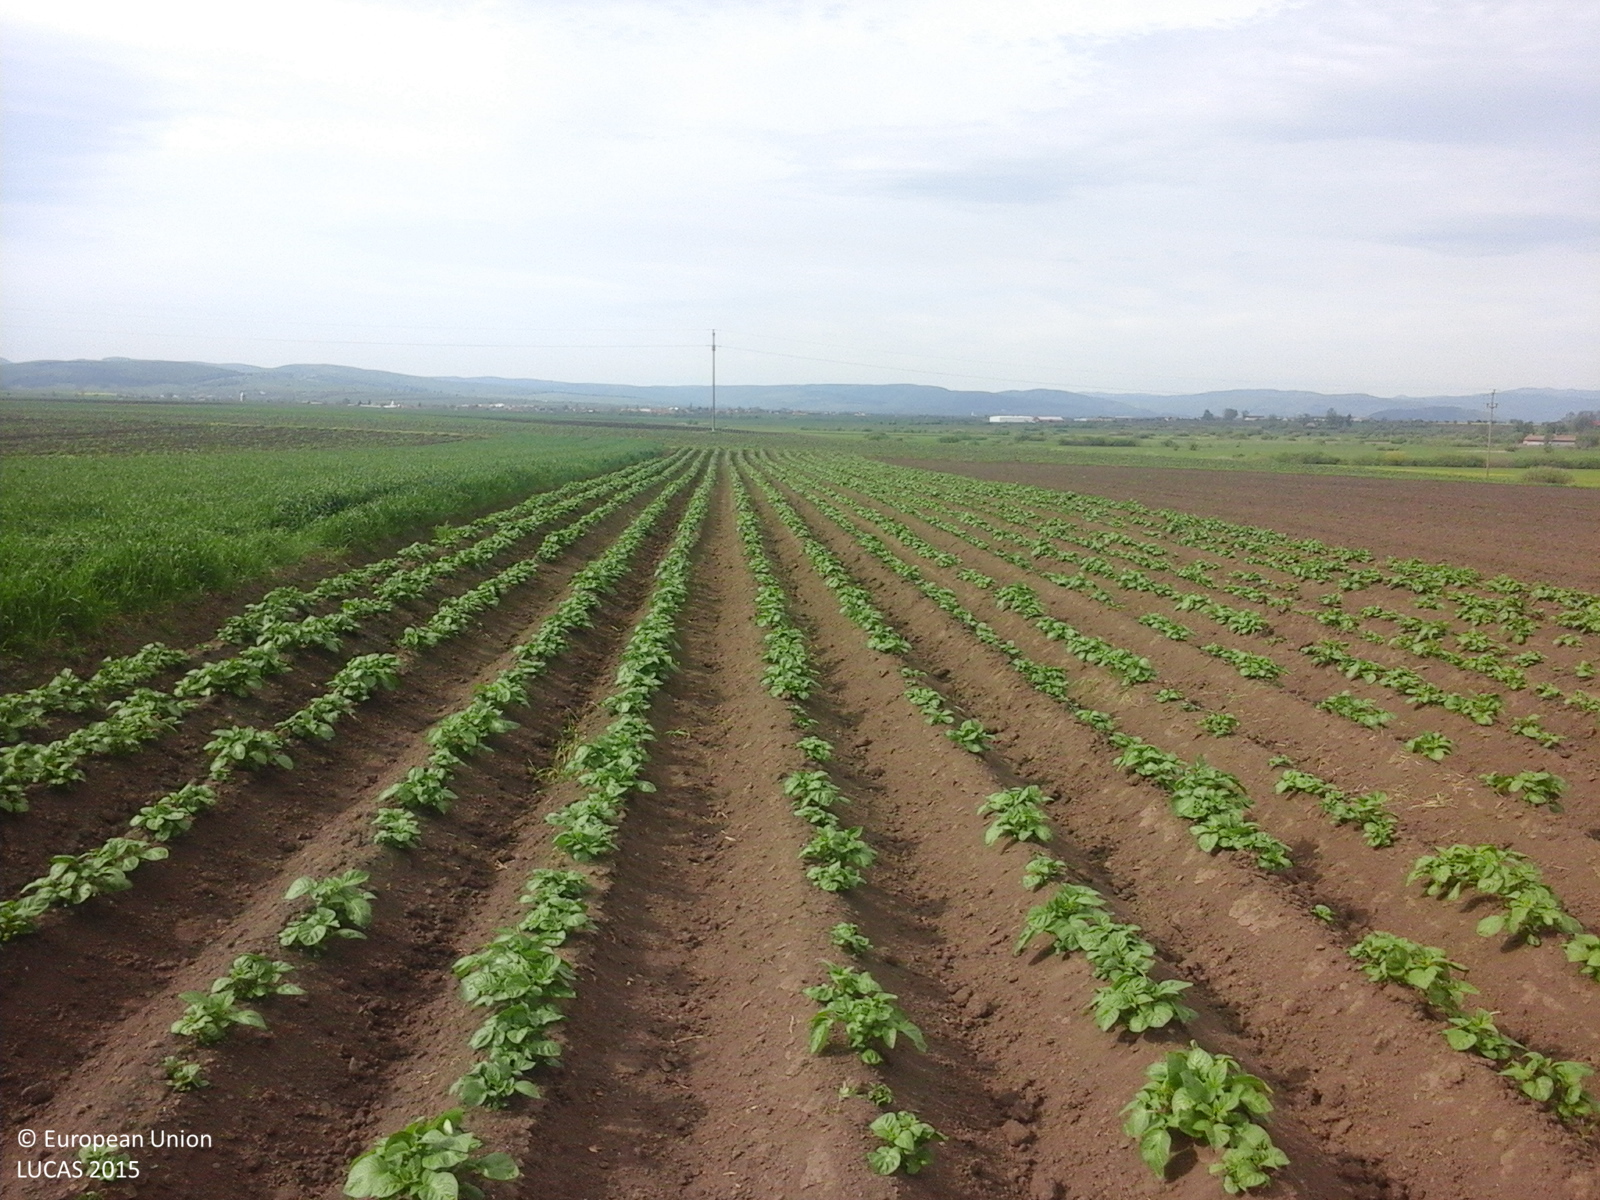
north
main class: Cropland
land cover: Potatoes
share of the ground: 10 - 25 %
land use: Agriculture (excluding fallow land and kitchen gardens)
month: May
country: RO
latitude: 45.9195
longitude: 26.0412
